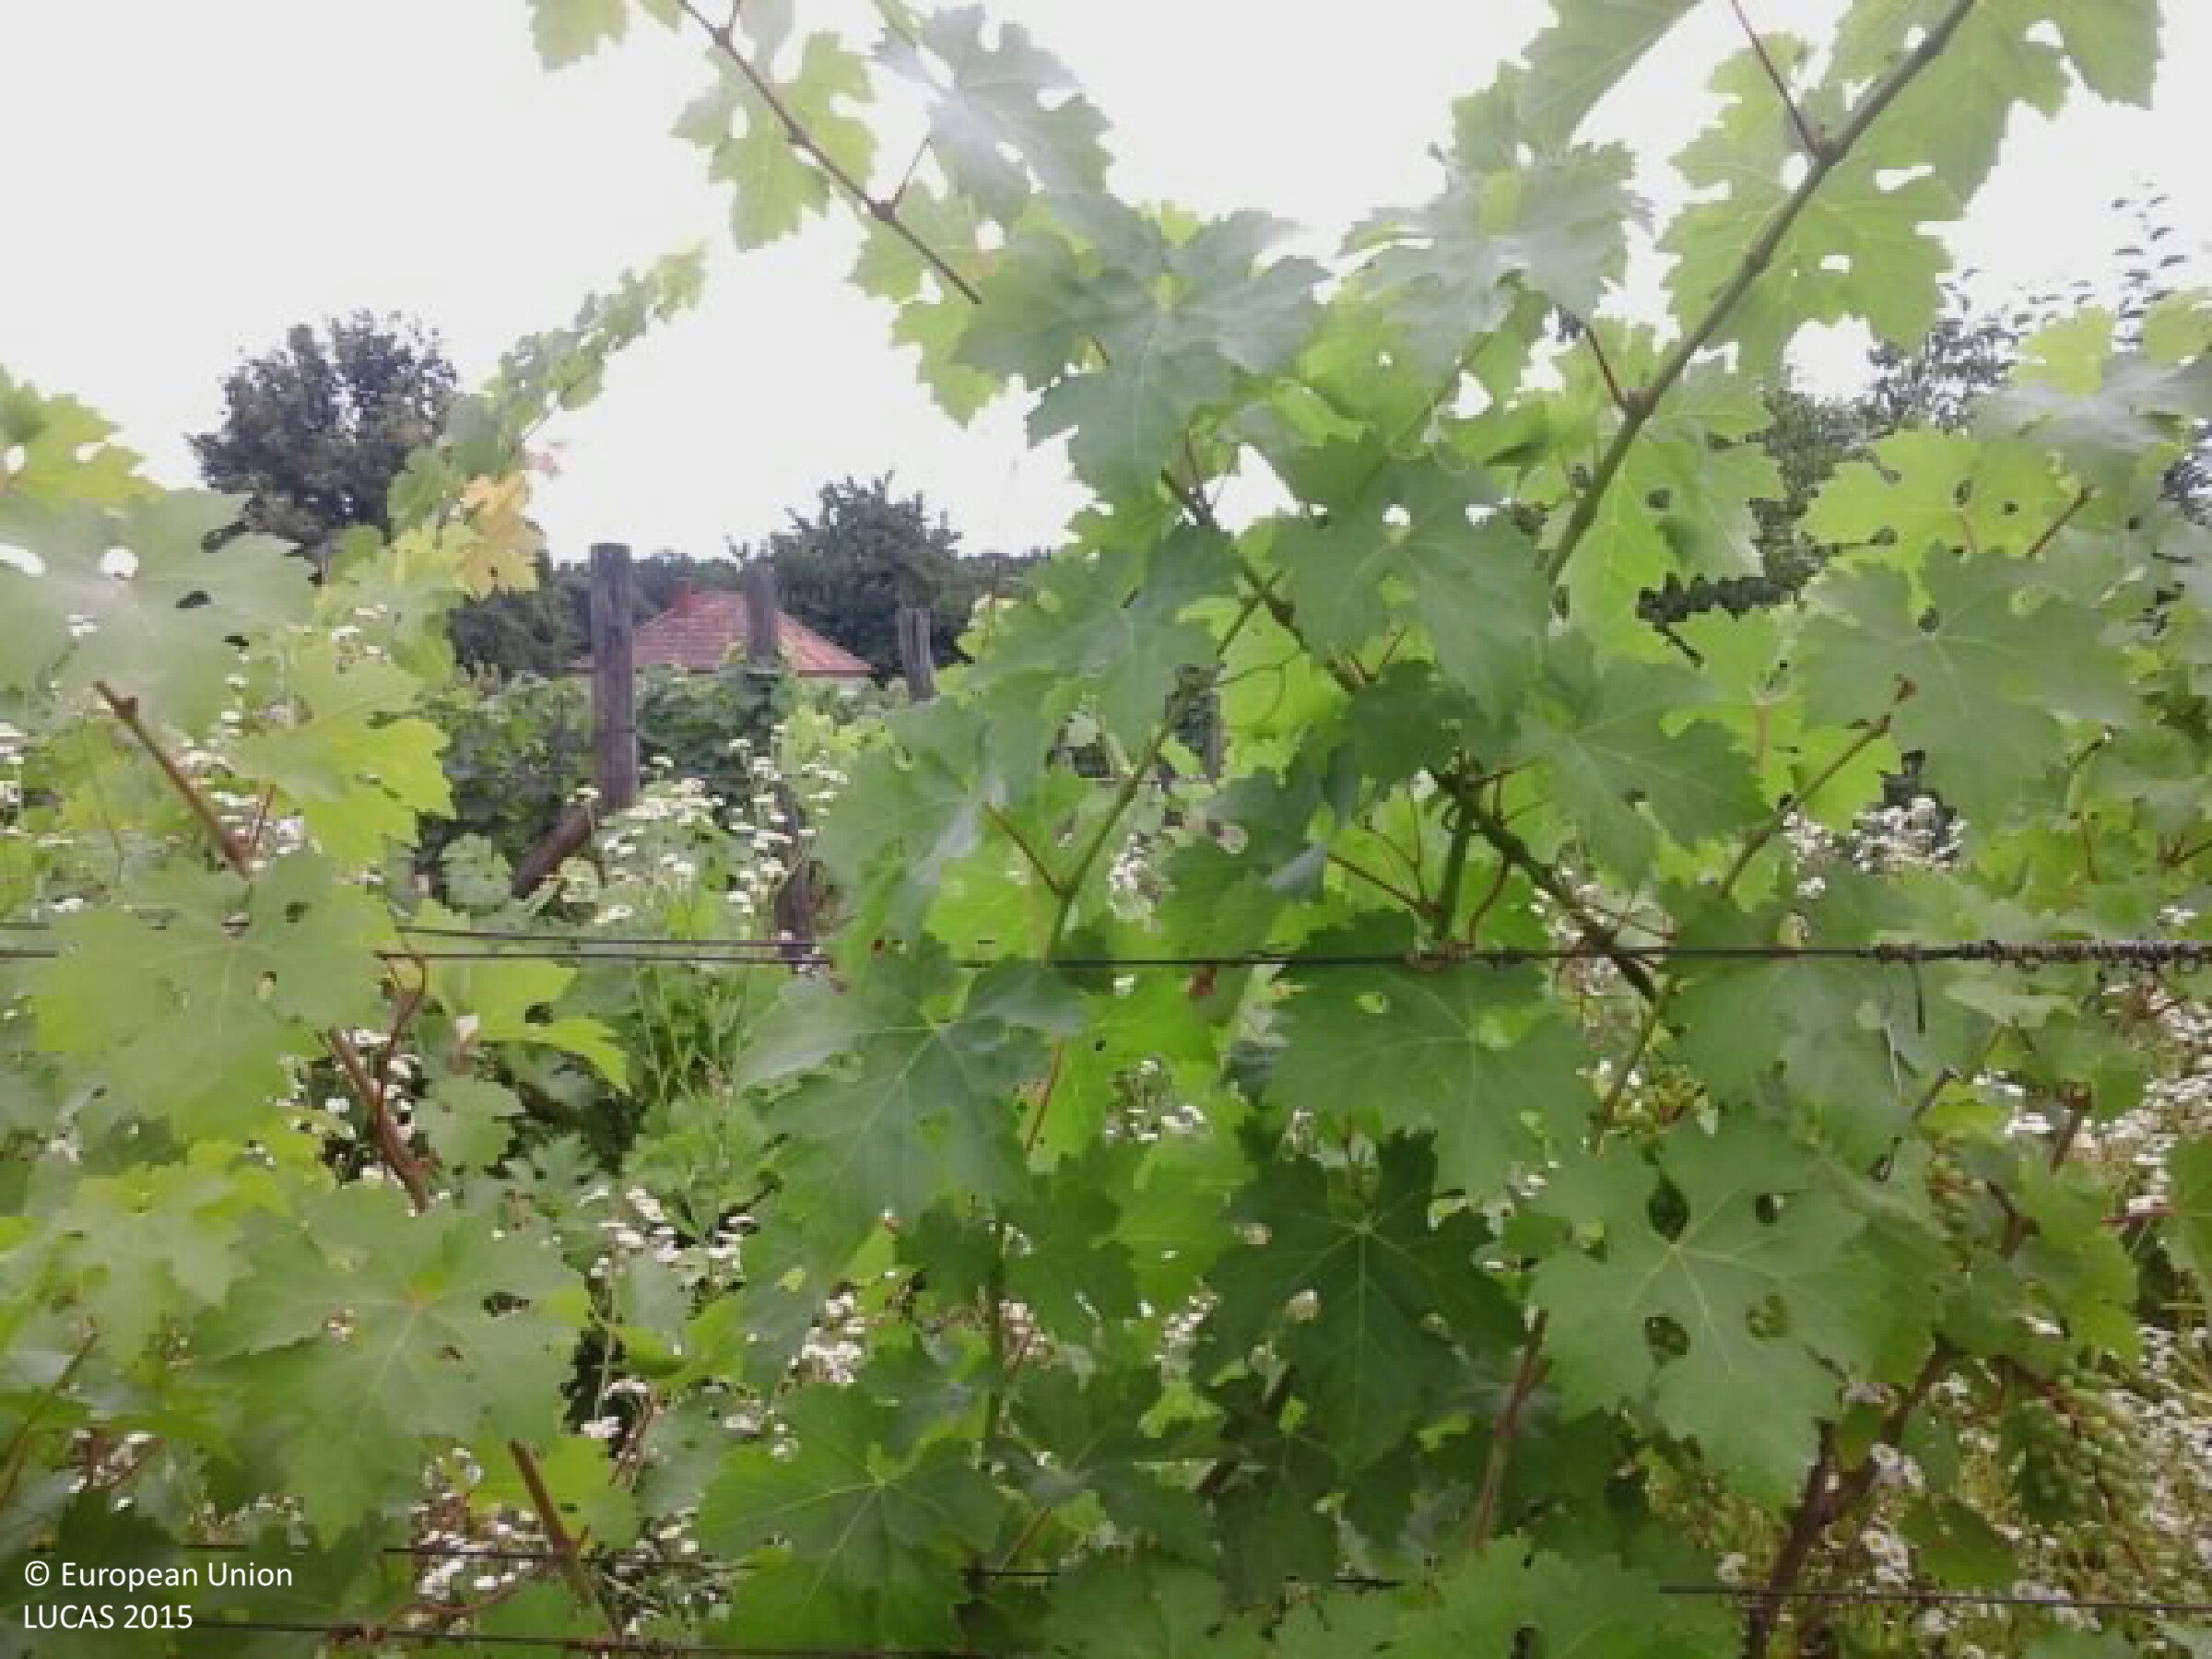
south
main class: Cropland
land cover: Vineyards
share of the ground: 25 - 50 %
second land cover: Spontaneously vegetated surfaces
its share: 50 - 75 %
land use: Abandoned areas
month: July
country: HU
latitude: 46.5124
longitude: 17.1064
